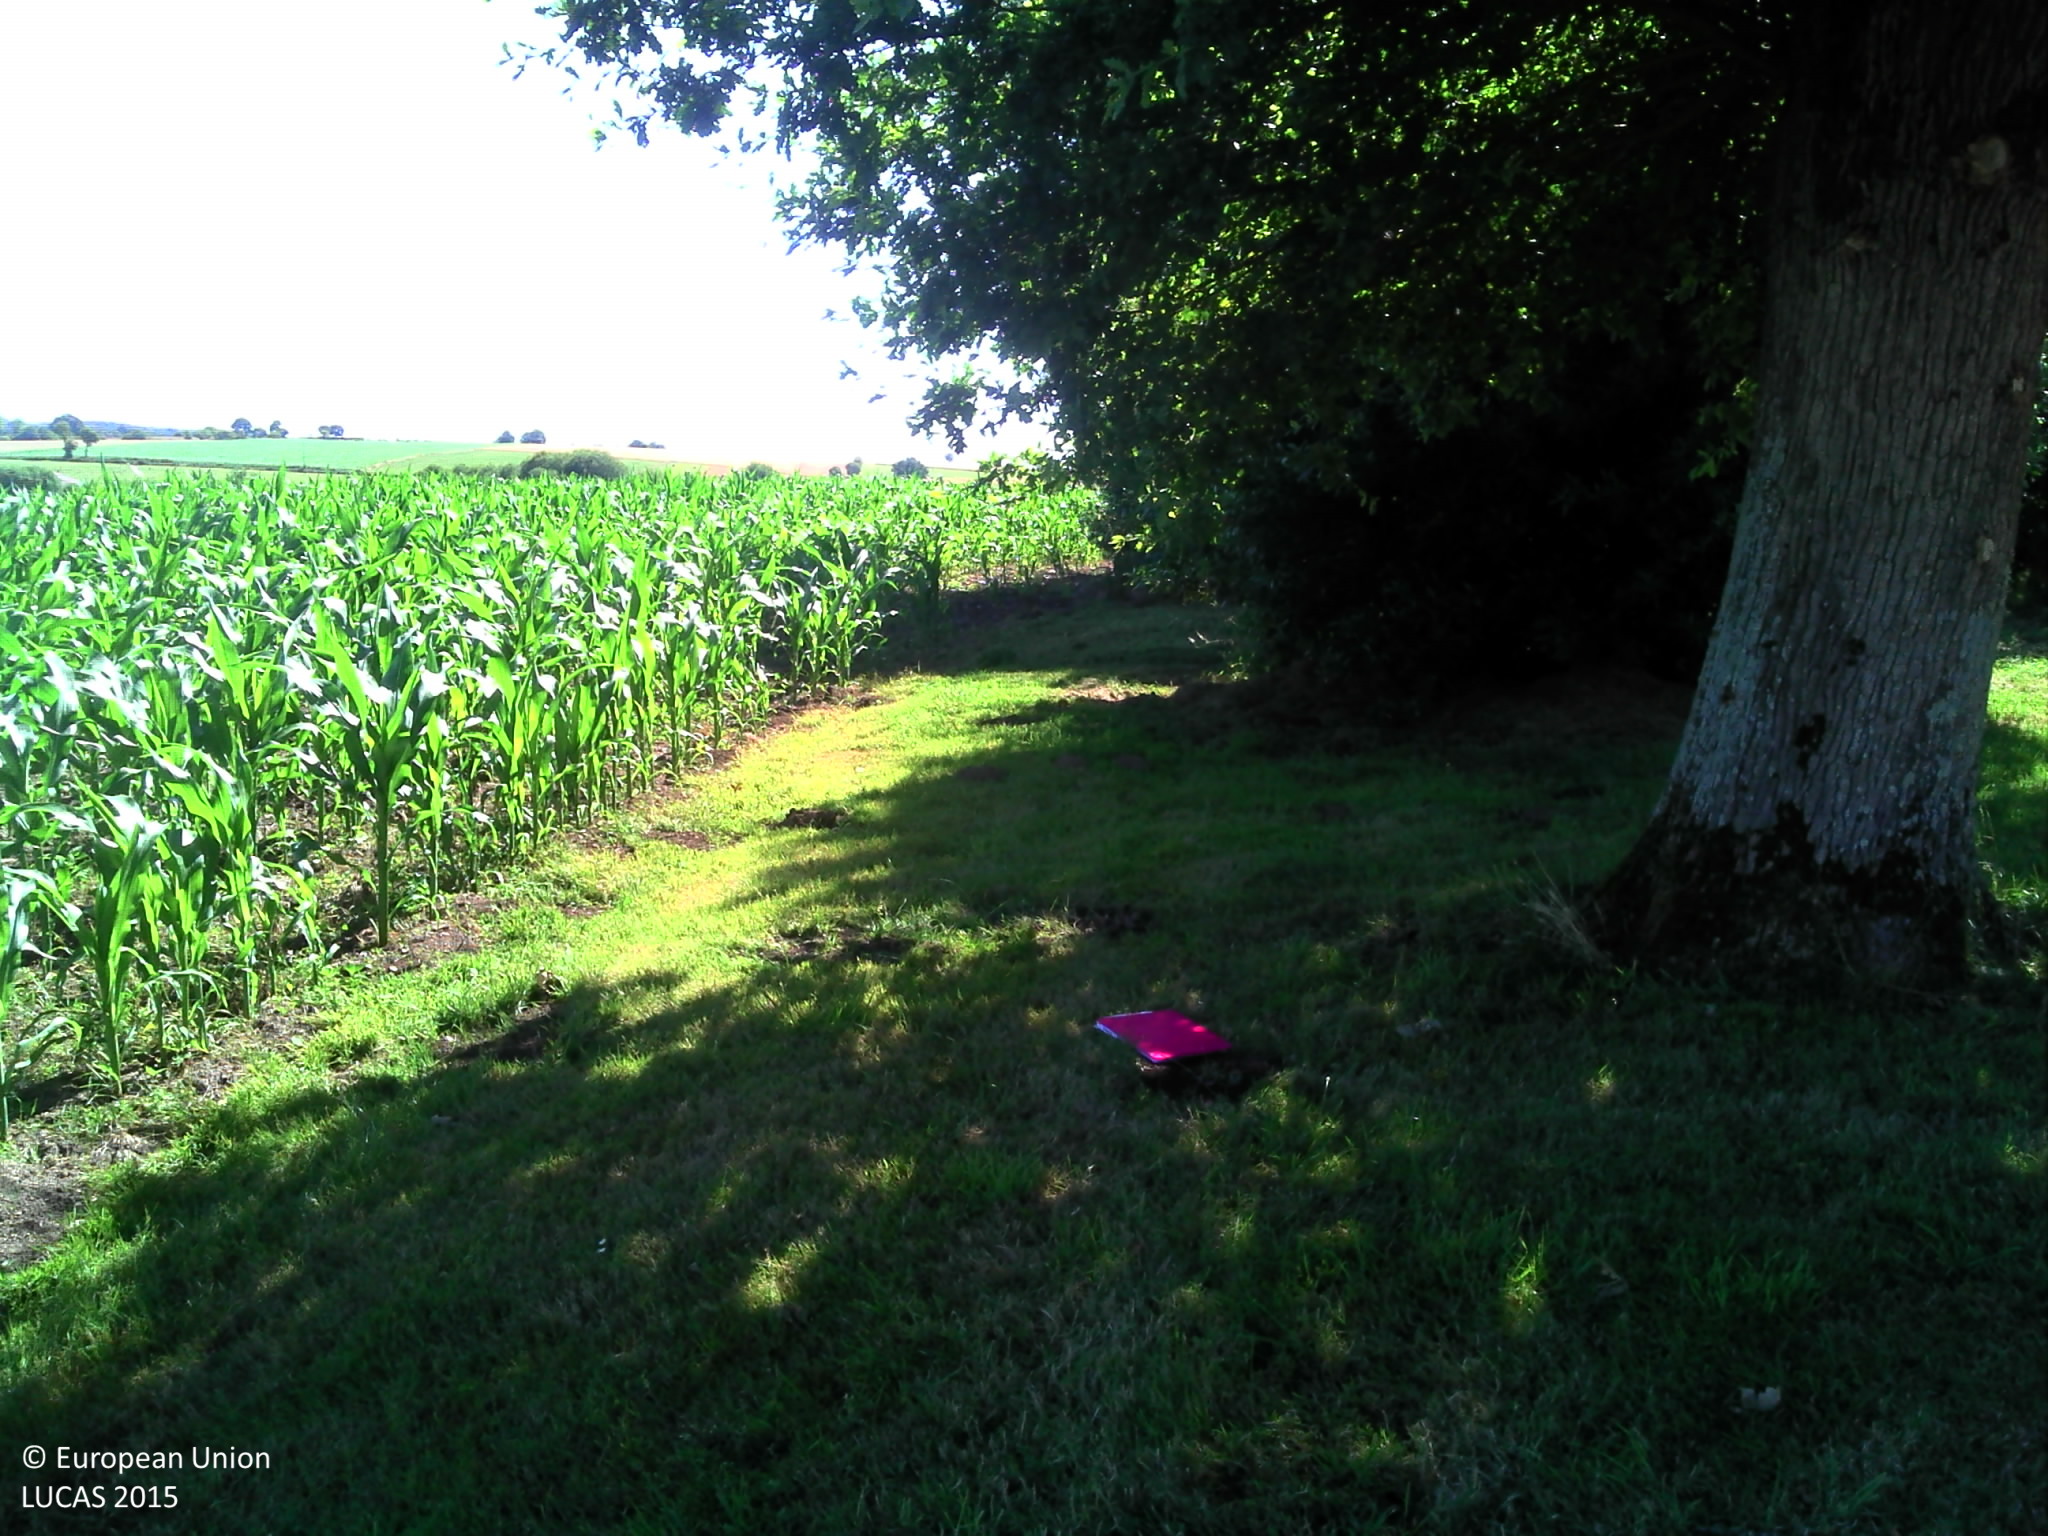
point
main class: Woodland
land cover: Broadleaved woodland
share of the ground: > 75 %
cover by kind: herbaceous plants 80 %, broadleaved forest trees 20 %
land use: Residential
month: July
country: FR
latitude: 47.7485
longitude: -1.9883
